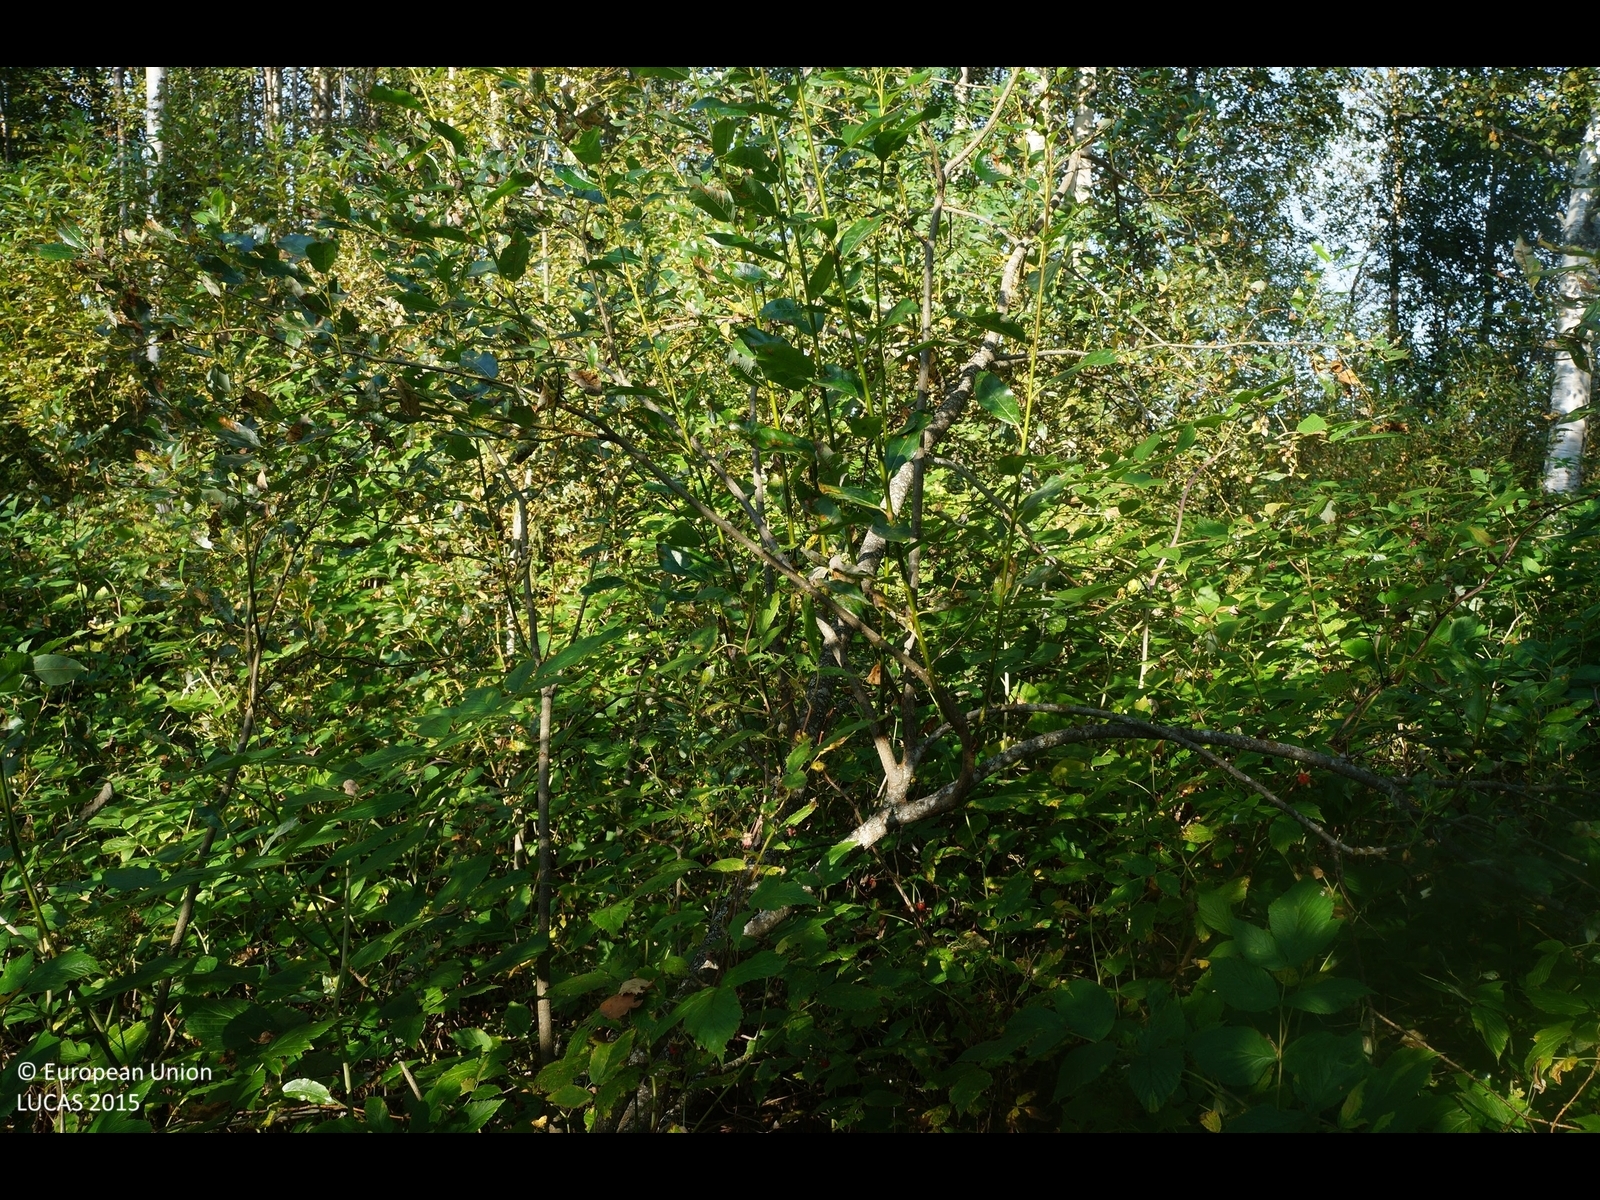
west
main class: Woodland
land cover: Broadleaved woodland
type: non-riverine alder, birch or aspen forest
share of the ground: 50 - 75 %
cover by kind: broadleaved forest trees 60 %, shrubs 30 %, herbaceous plants 10 %
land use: Semi-natural and natural areas not in use
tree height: > 5 m
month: August
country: FI
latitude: 64.0901
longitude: 25.3313
